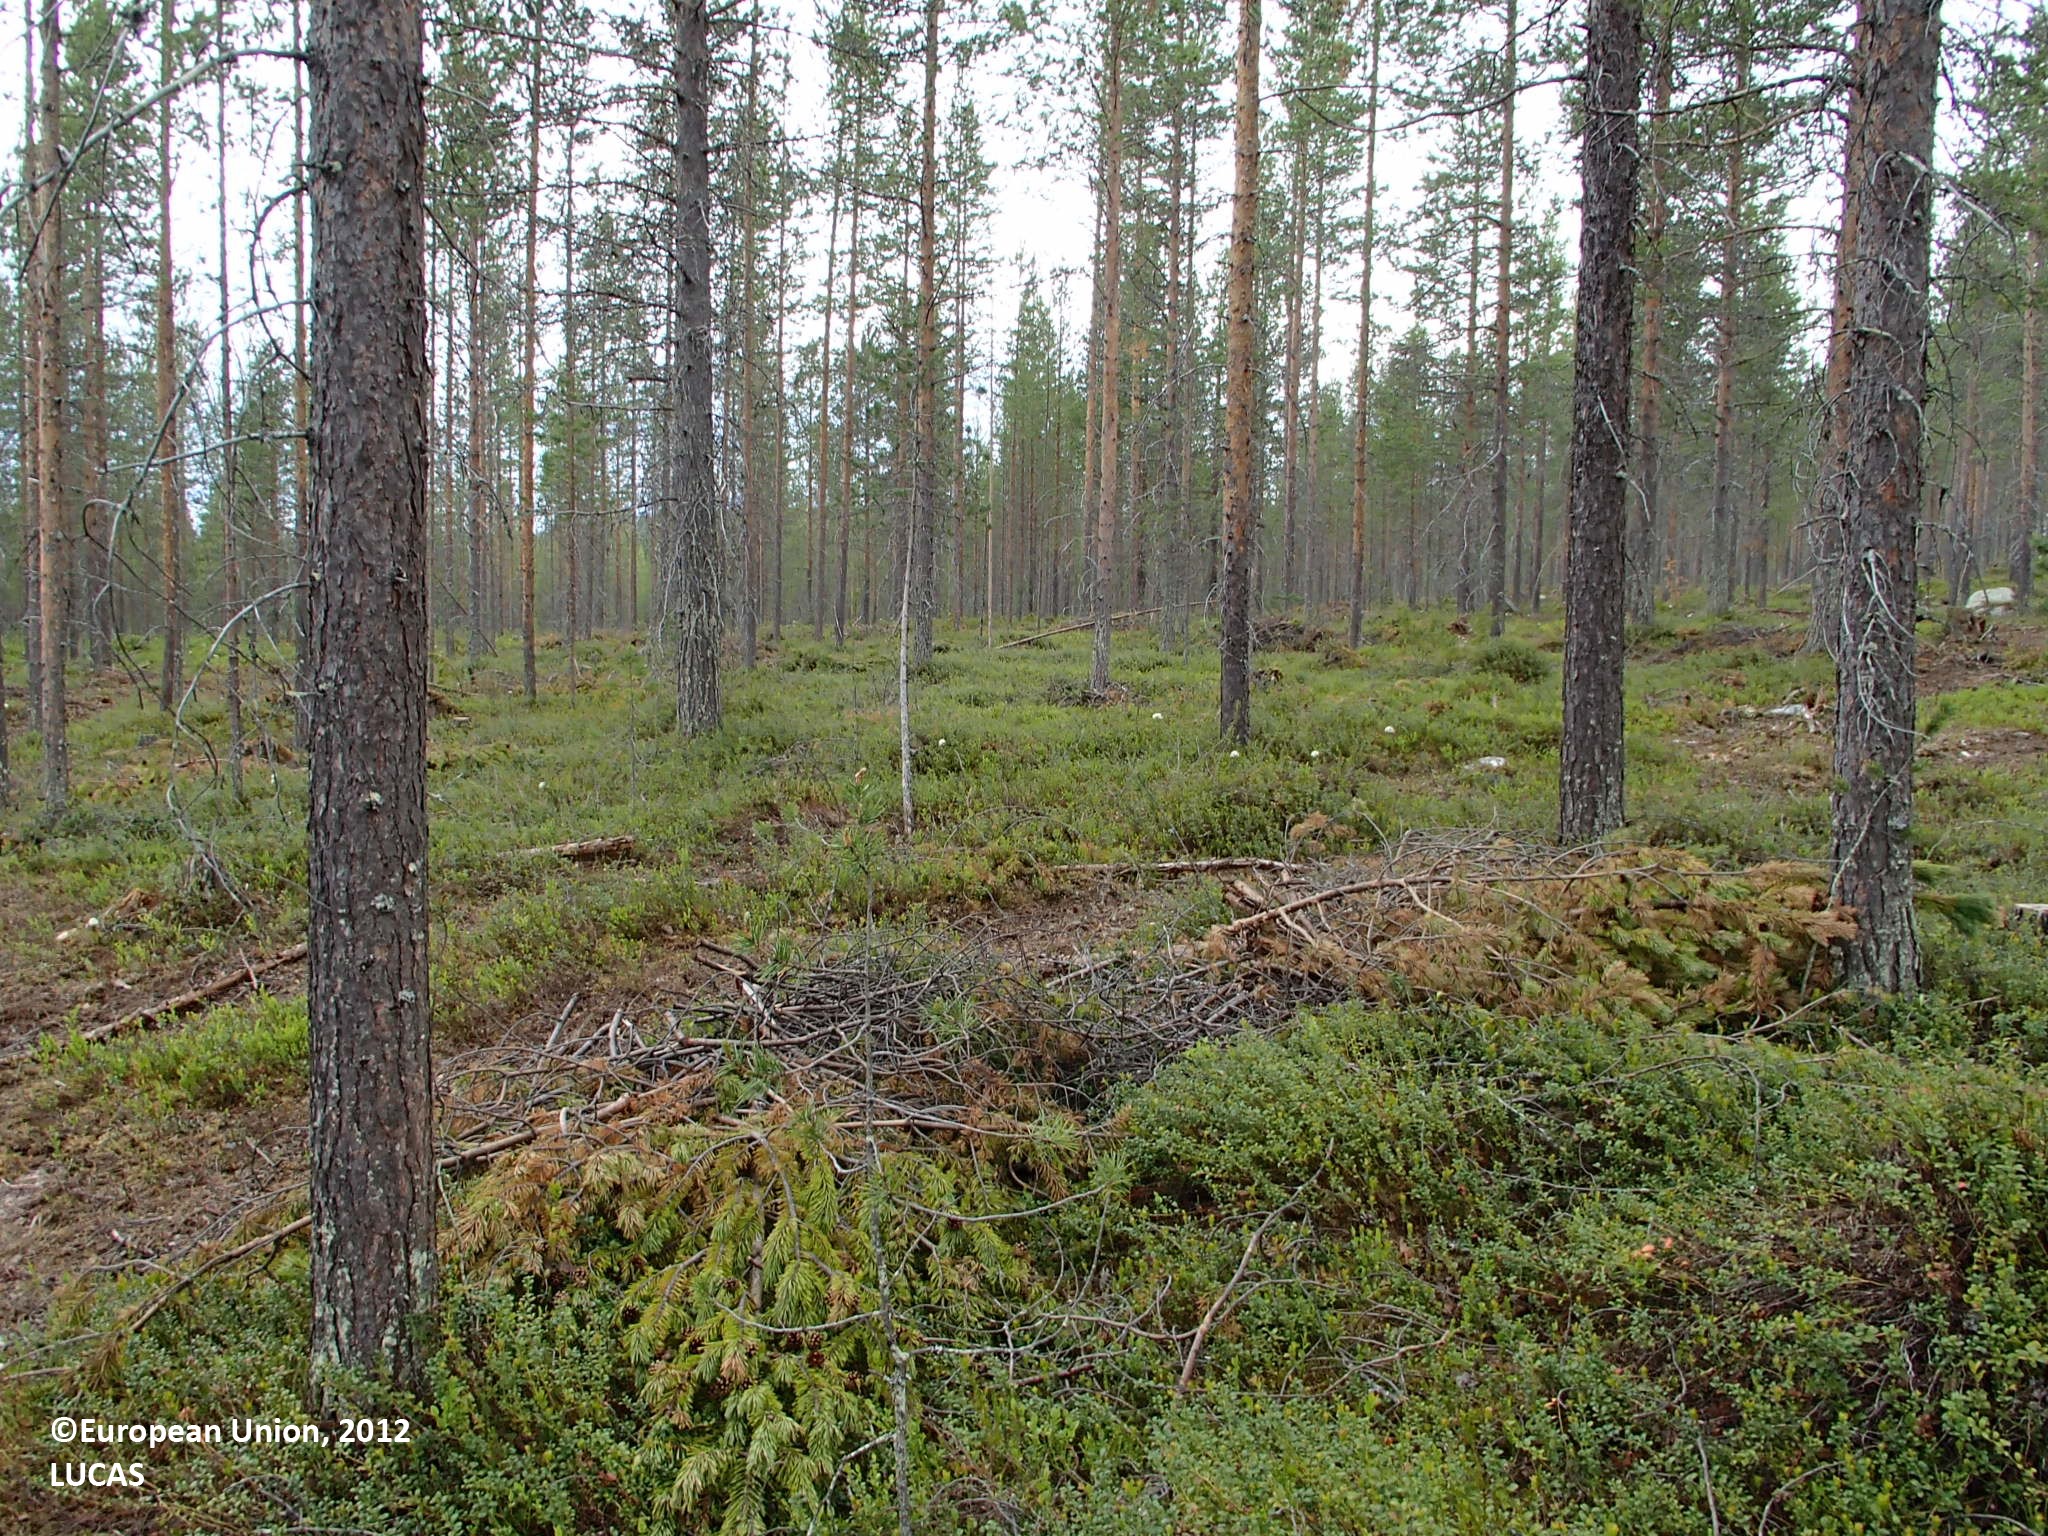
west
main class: Woodland
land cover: Pine dominated coniferous woodland
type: boreal forest
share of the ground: > 75 %
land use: Forestry
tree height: > 5 m
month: June
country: FI
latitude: 66.5895
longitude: 27.7817
